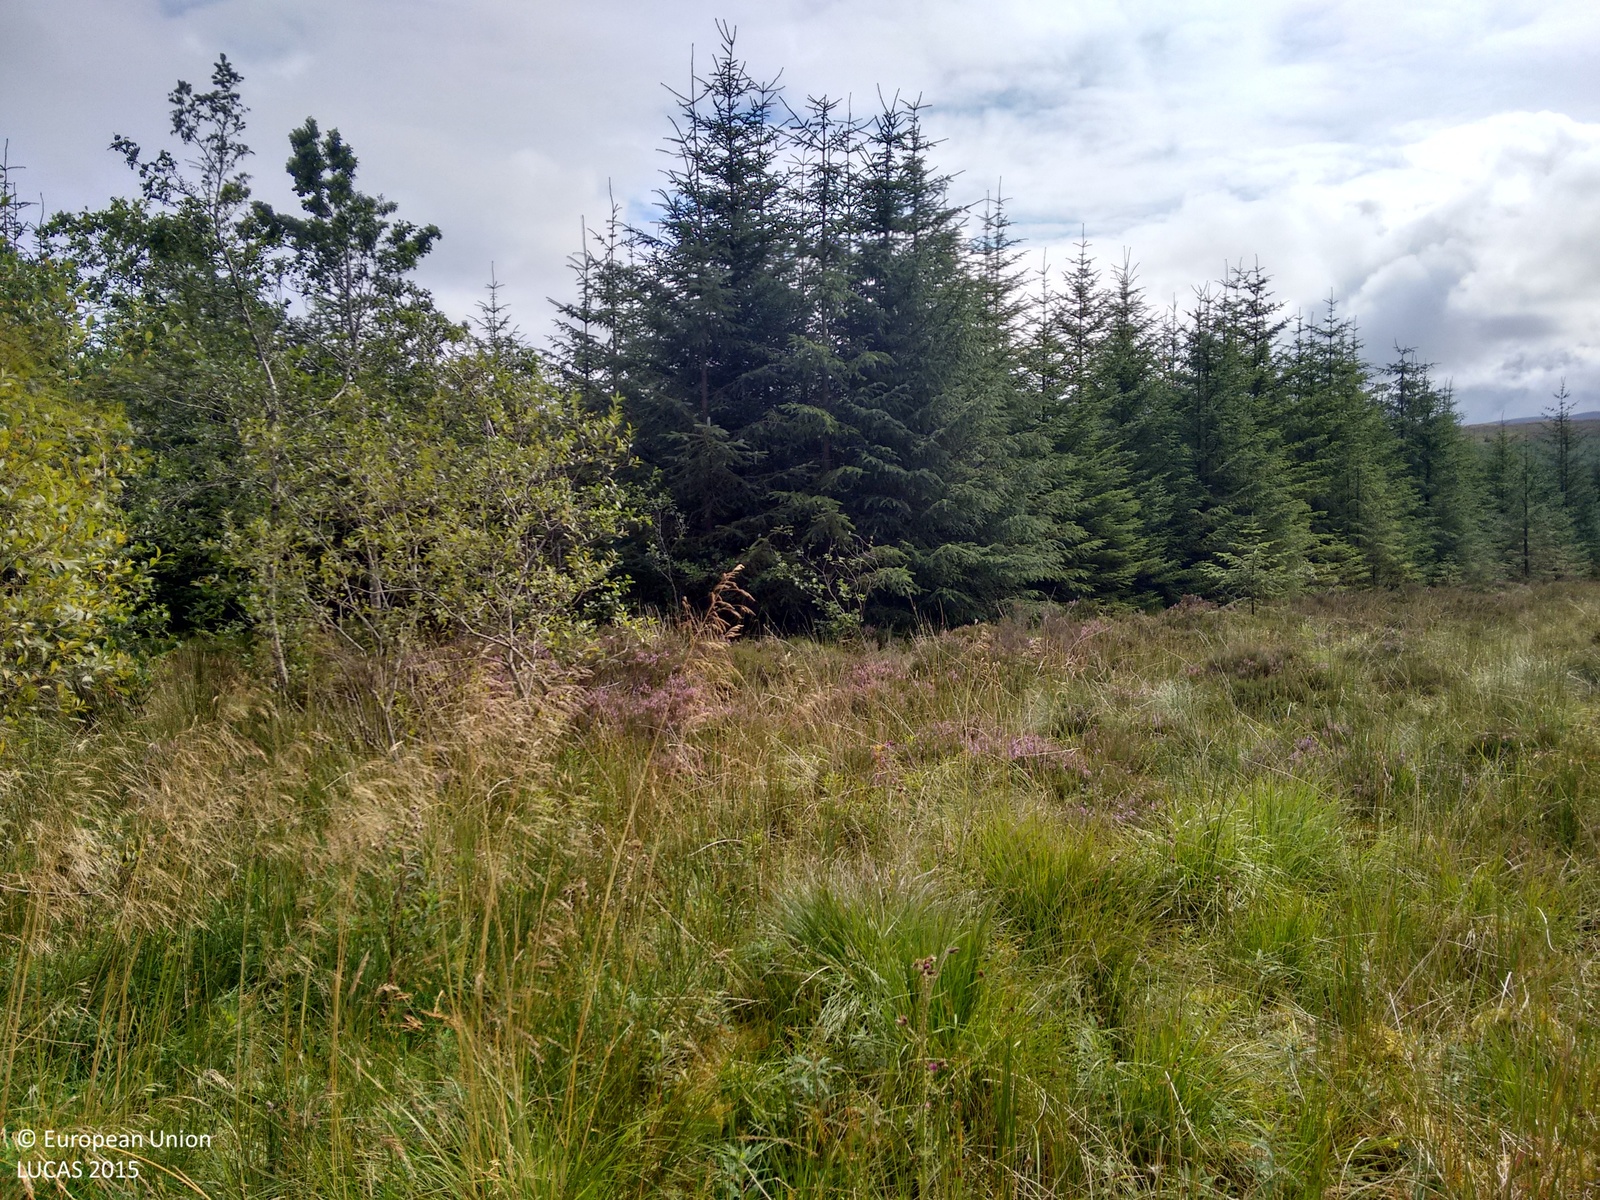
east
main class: Woodland
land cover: Spruce dominated coniferous woodland
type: exotic forest
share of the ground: > 75 %
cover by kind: coniferous forest trees 100 %
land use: Forestry
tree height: > 5 m
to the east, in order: Spruce dominated coniferous woodland; Other structural elements; Spruce dominated coniferous woodland
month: September
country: GB
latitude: 55.2416
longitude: -4.5560
